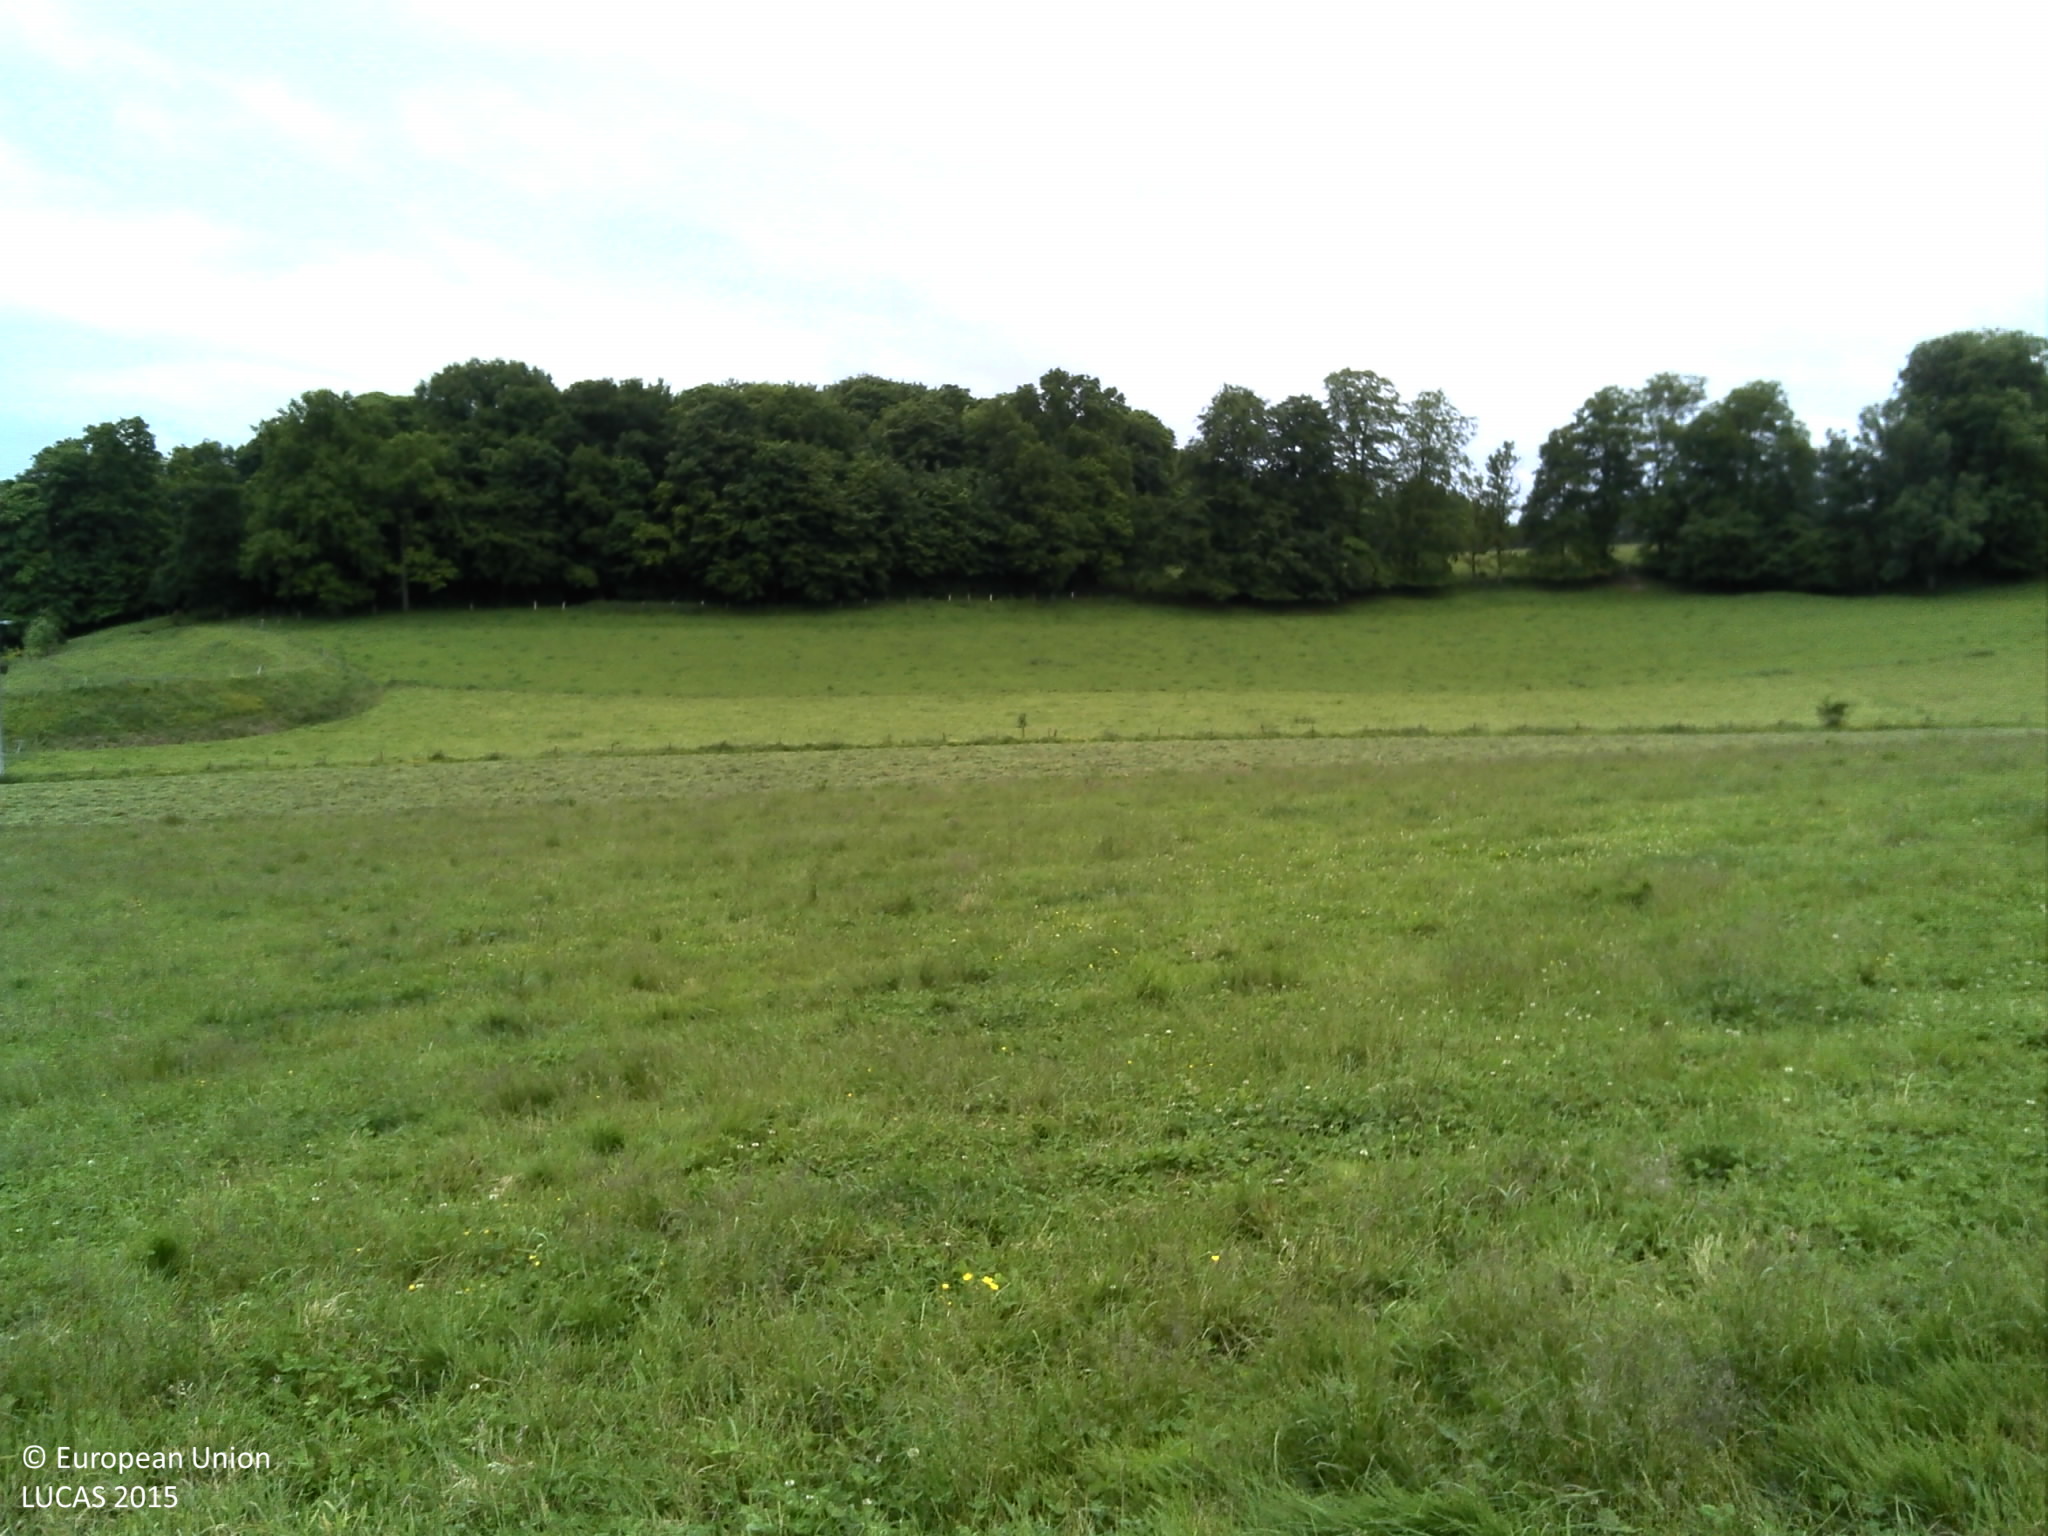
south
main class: Grassland
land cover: Grassland without tree/shrub cover
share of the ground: > 75 %
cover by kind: herbaceous plants 100 %
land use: Agriculture (excluding fallow land and kitchen gardens)
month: June
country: FR
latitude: 49.5545
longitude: 0.9784
